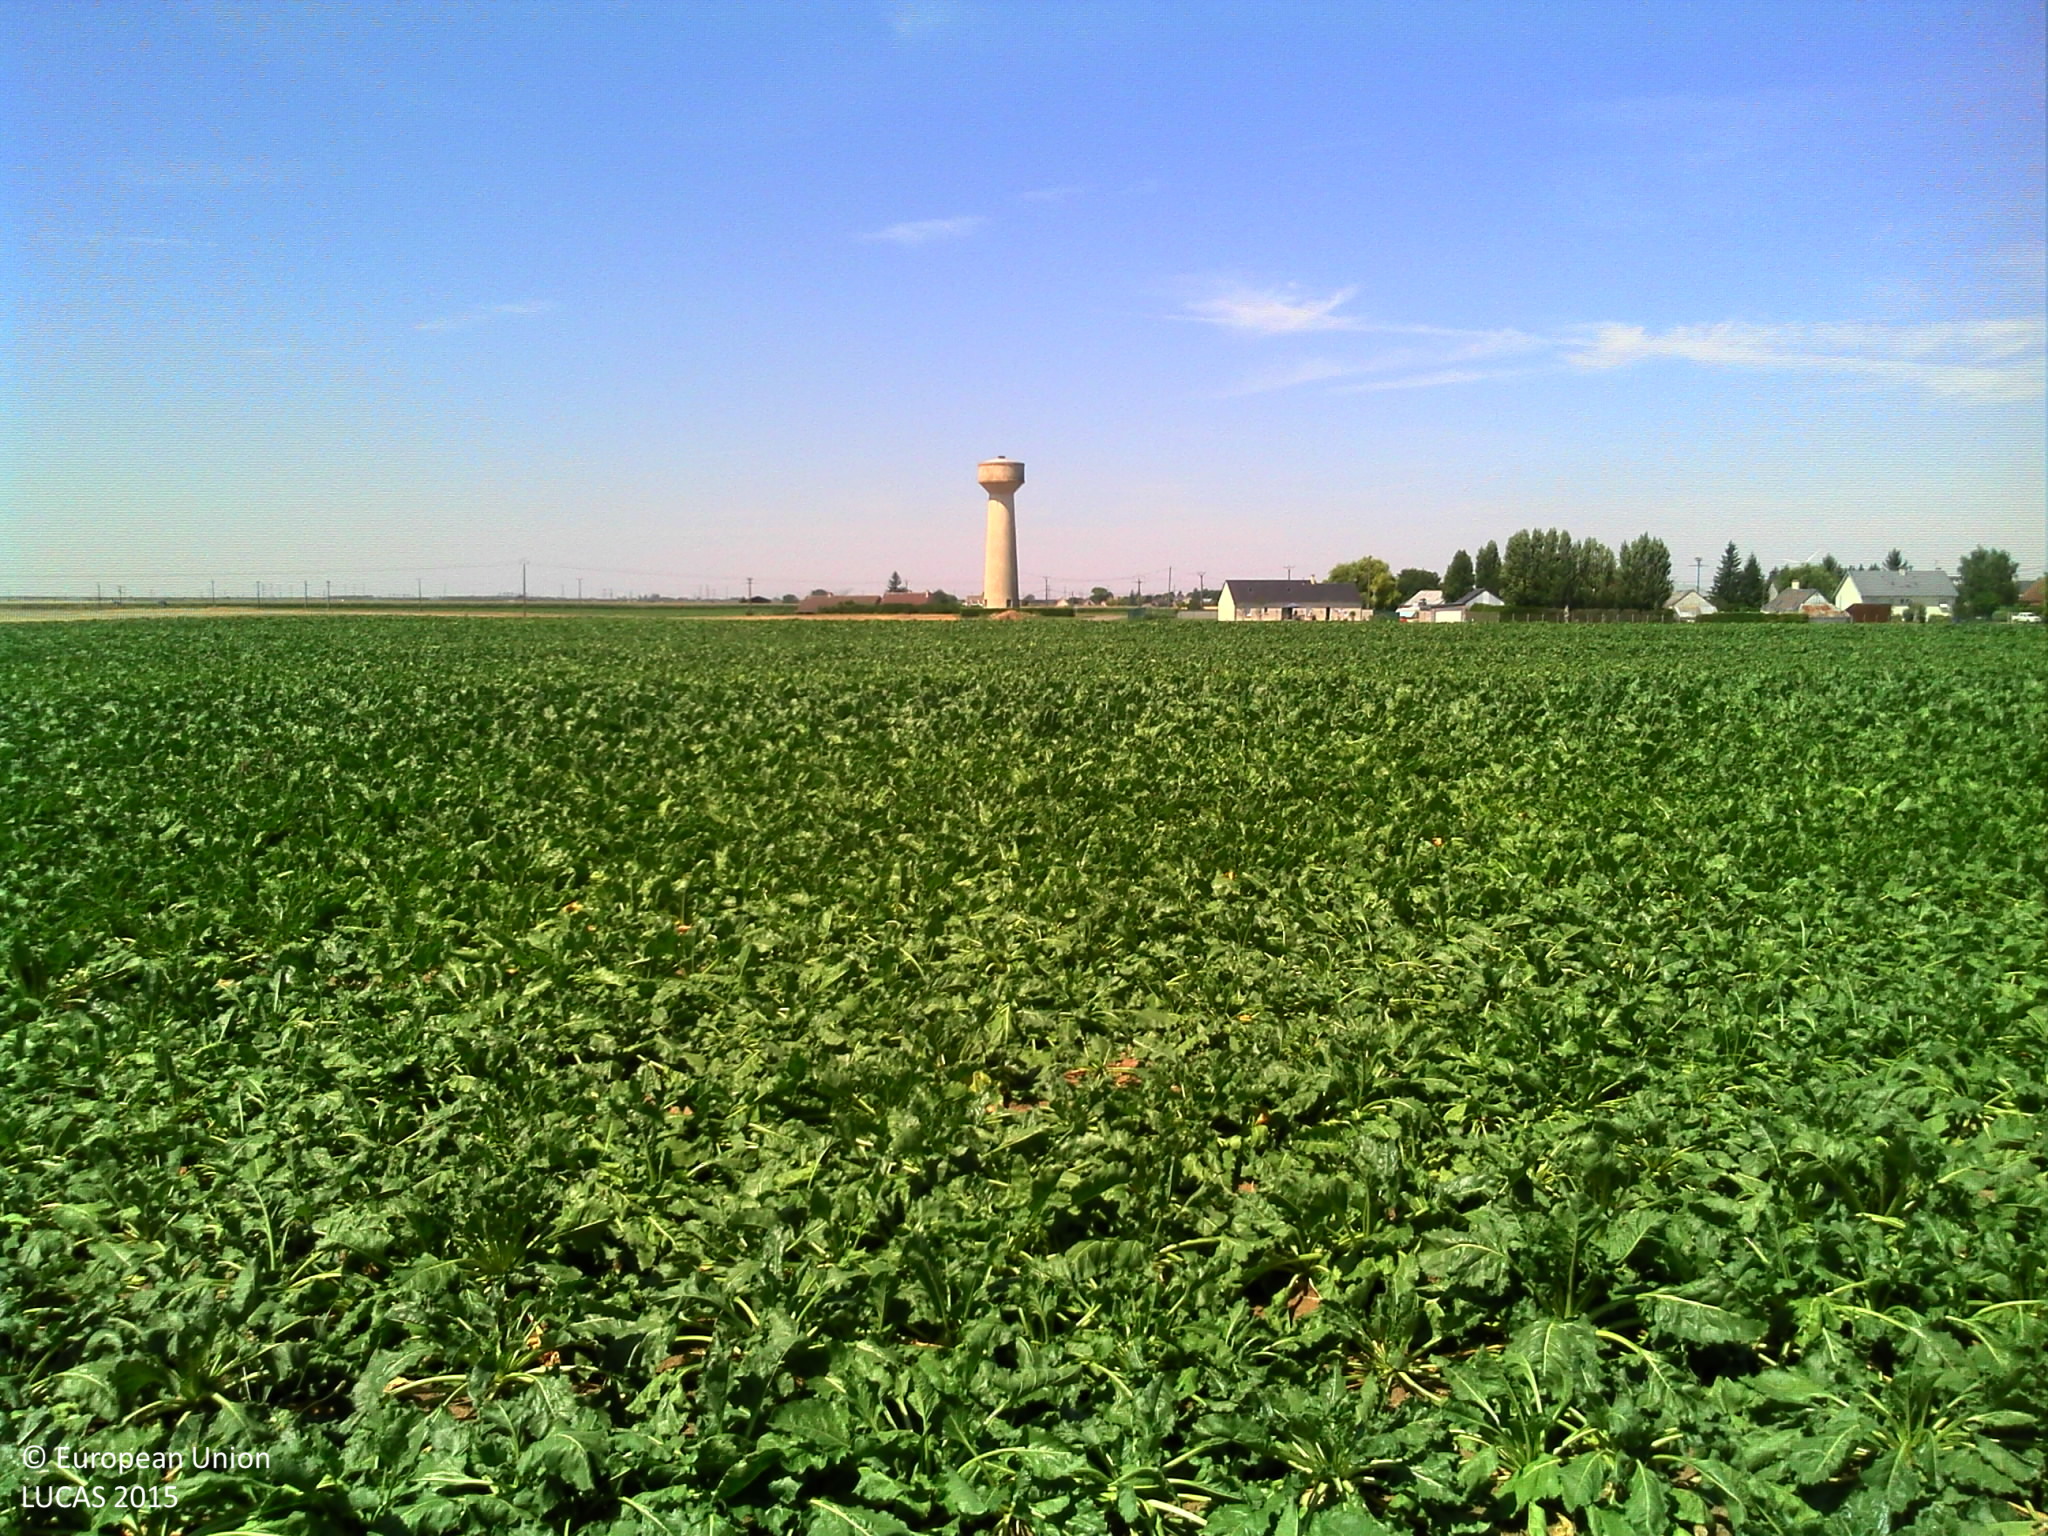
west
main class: Cropland
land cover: Sugar beet
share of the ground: > 75 %
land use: Agriculture (excluding fallow land and kitchen gardens)
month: August
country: FR
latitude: 48.1091
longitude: 1.9420
